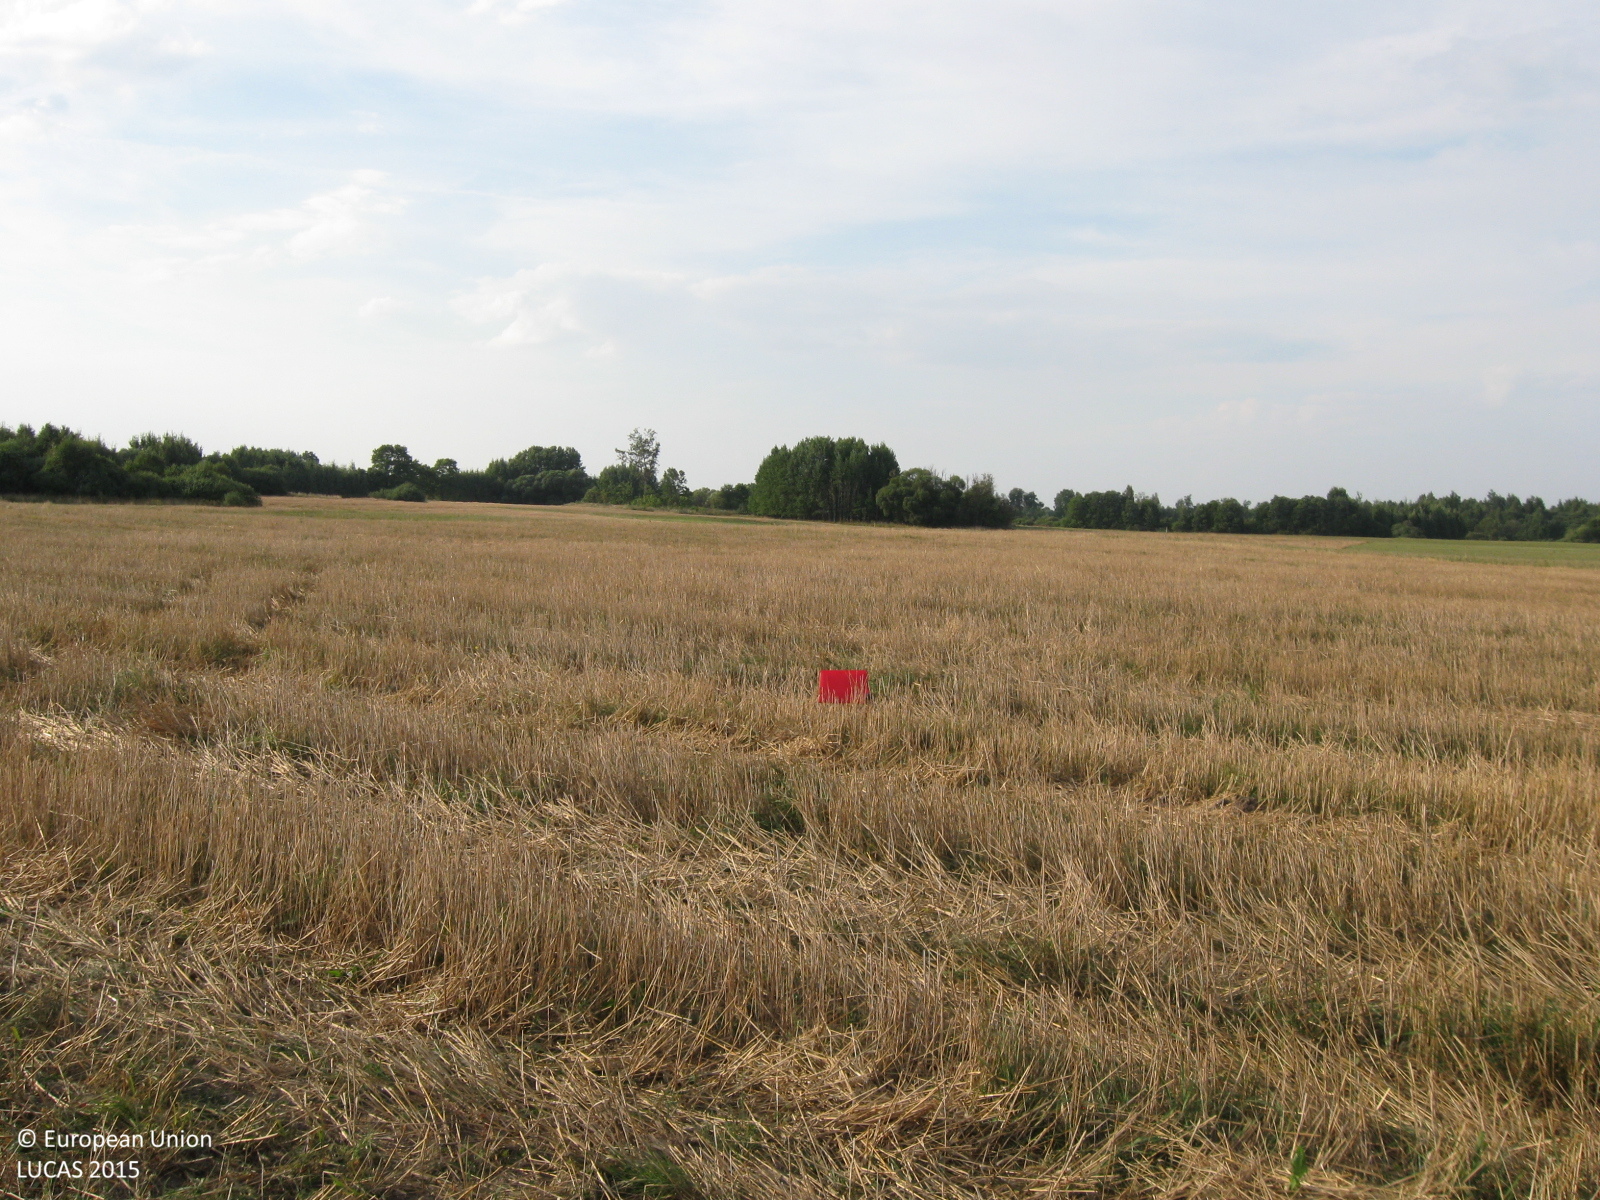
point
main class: Cropland
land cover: Durum wheat
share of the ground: > 75 %
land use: Agriculture (excluding fallow land and kitchen gardens)
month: August
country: LT
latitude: 55.5778
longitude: 22.9969
